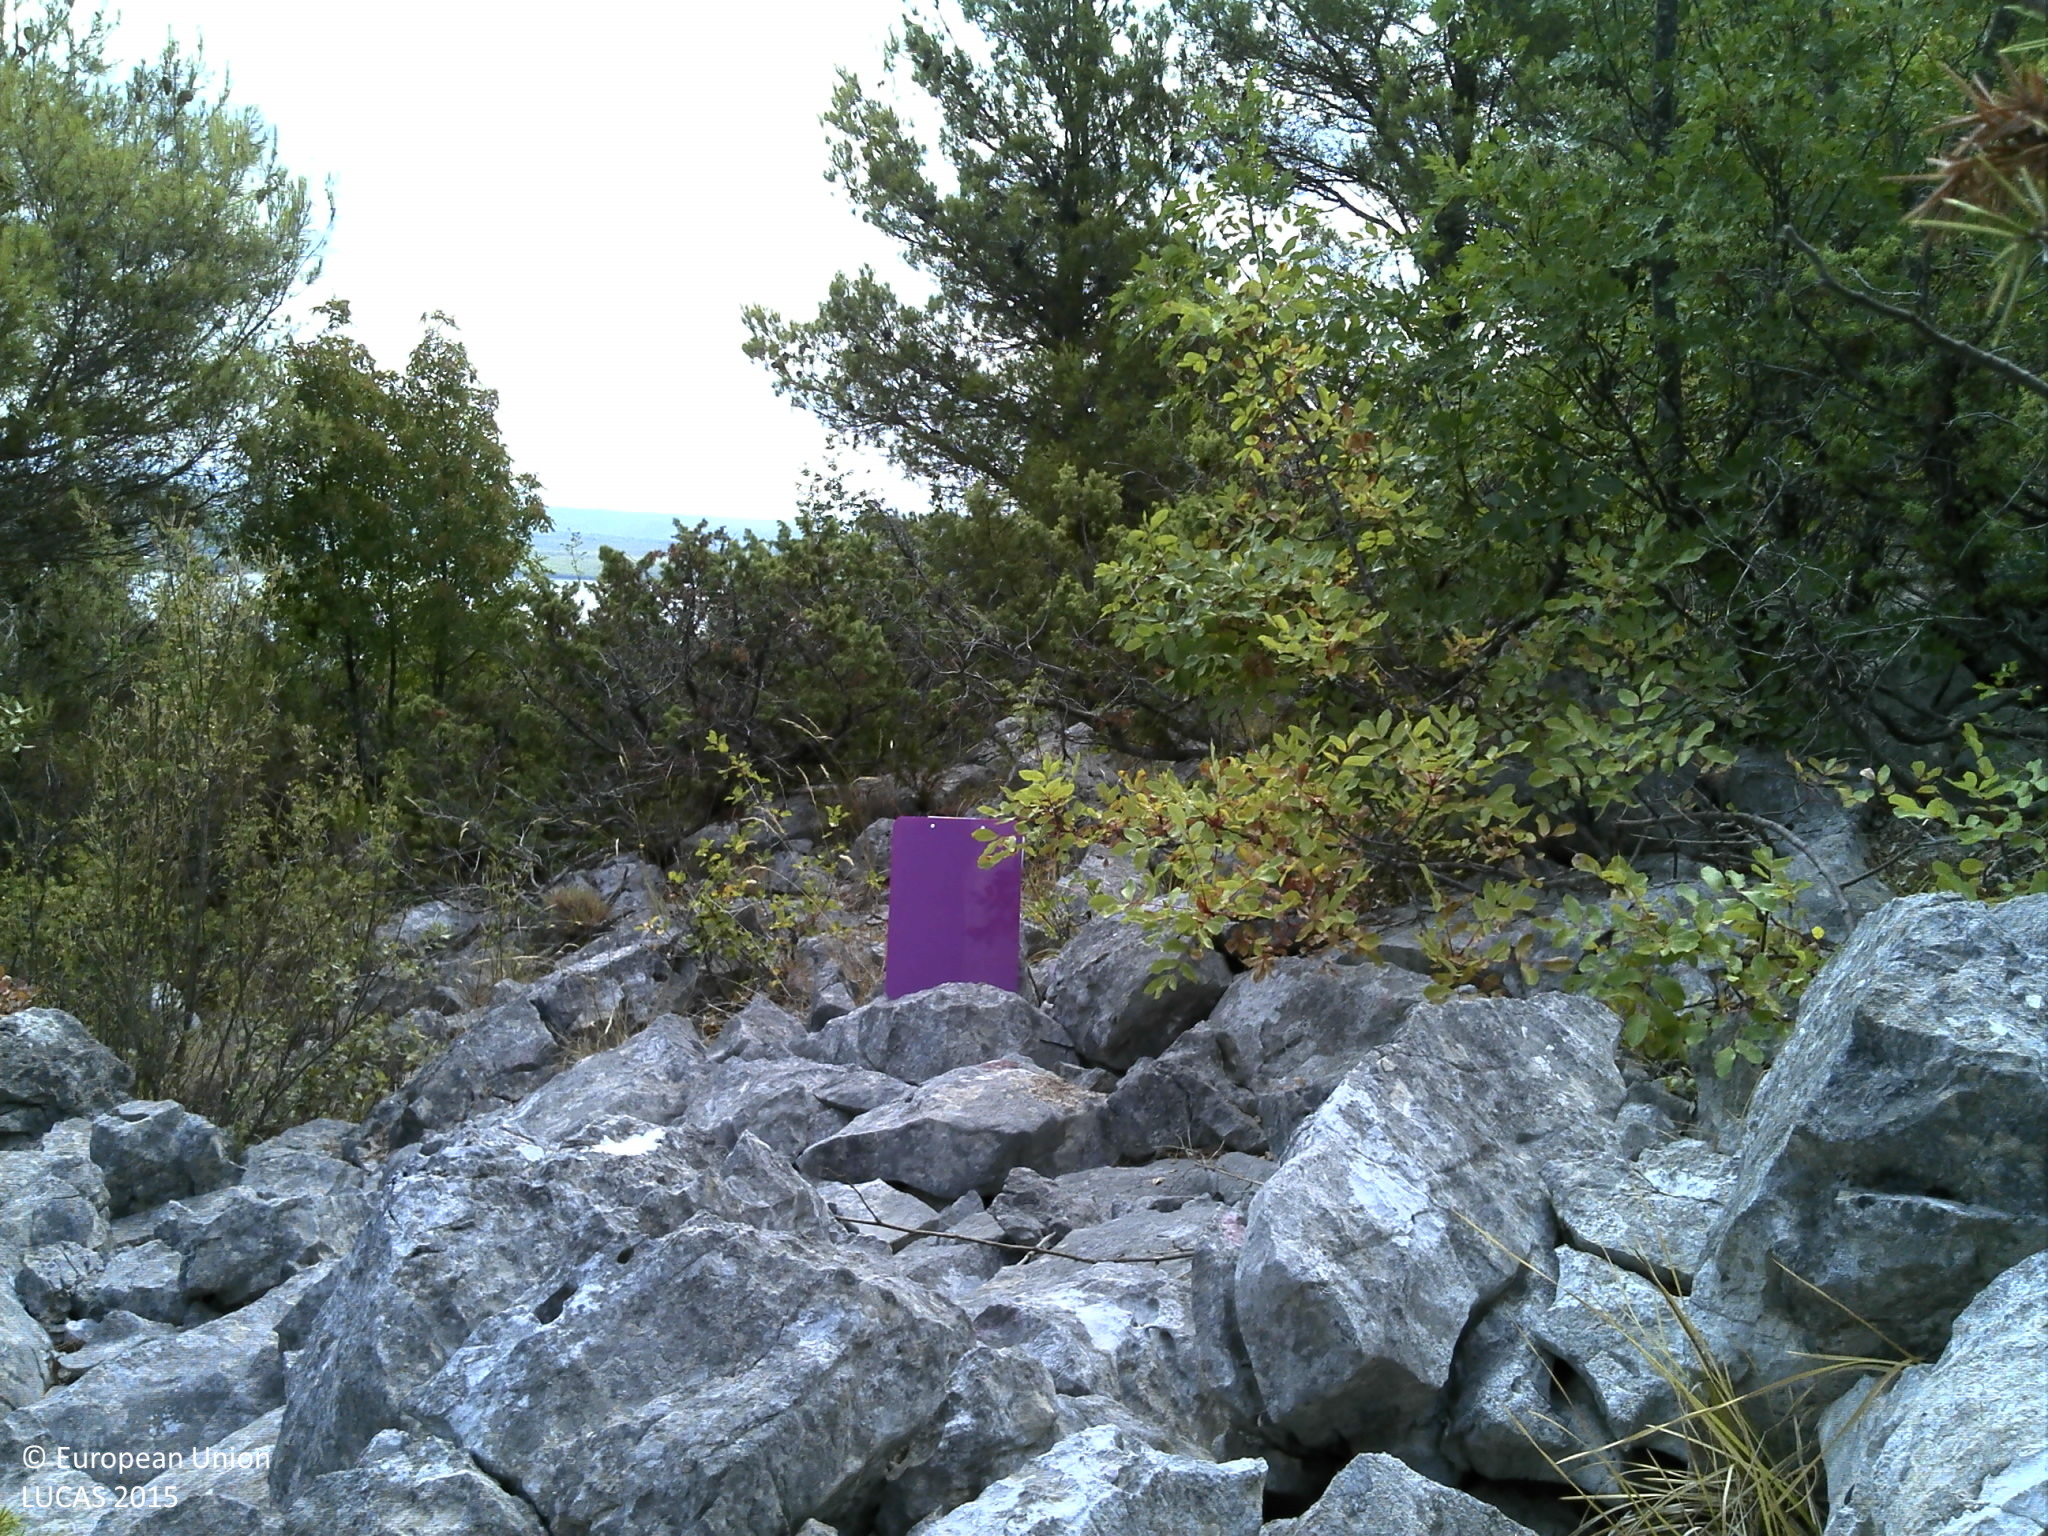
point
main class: Woodland
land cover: Pine dominated coniferous woodland
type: coniferous forest of the mediterranean region
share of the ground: 25 - 50 %
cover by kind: shrubs 40 %, coniferous forest trees 35 %, consolidated bare surface 15 %, broadleaved forest trees 5 %, unconsolidated bare surface 5 %
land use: Semi-natural and natural areas not in use
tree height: > 5 m
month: July
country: HR
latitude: 43.8060
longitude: 15.8460
